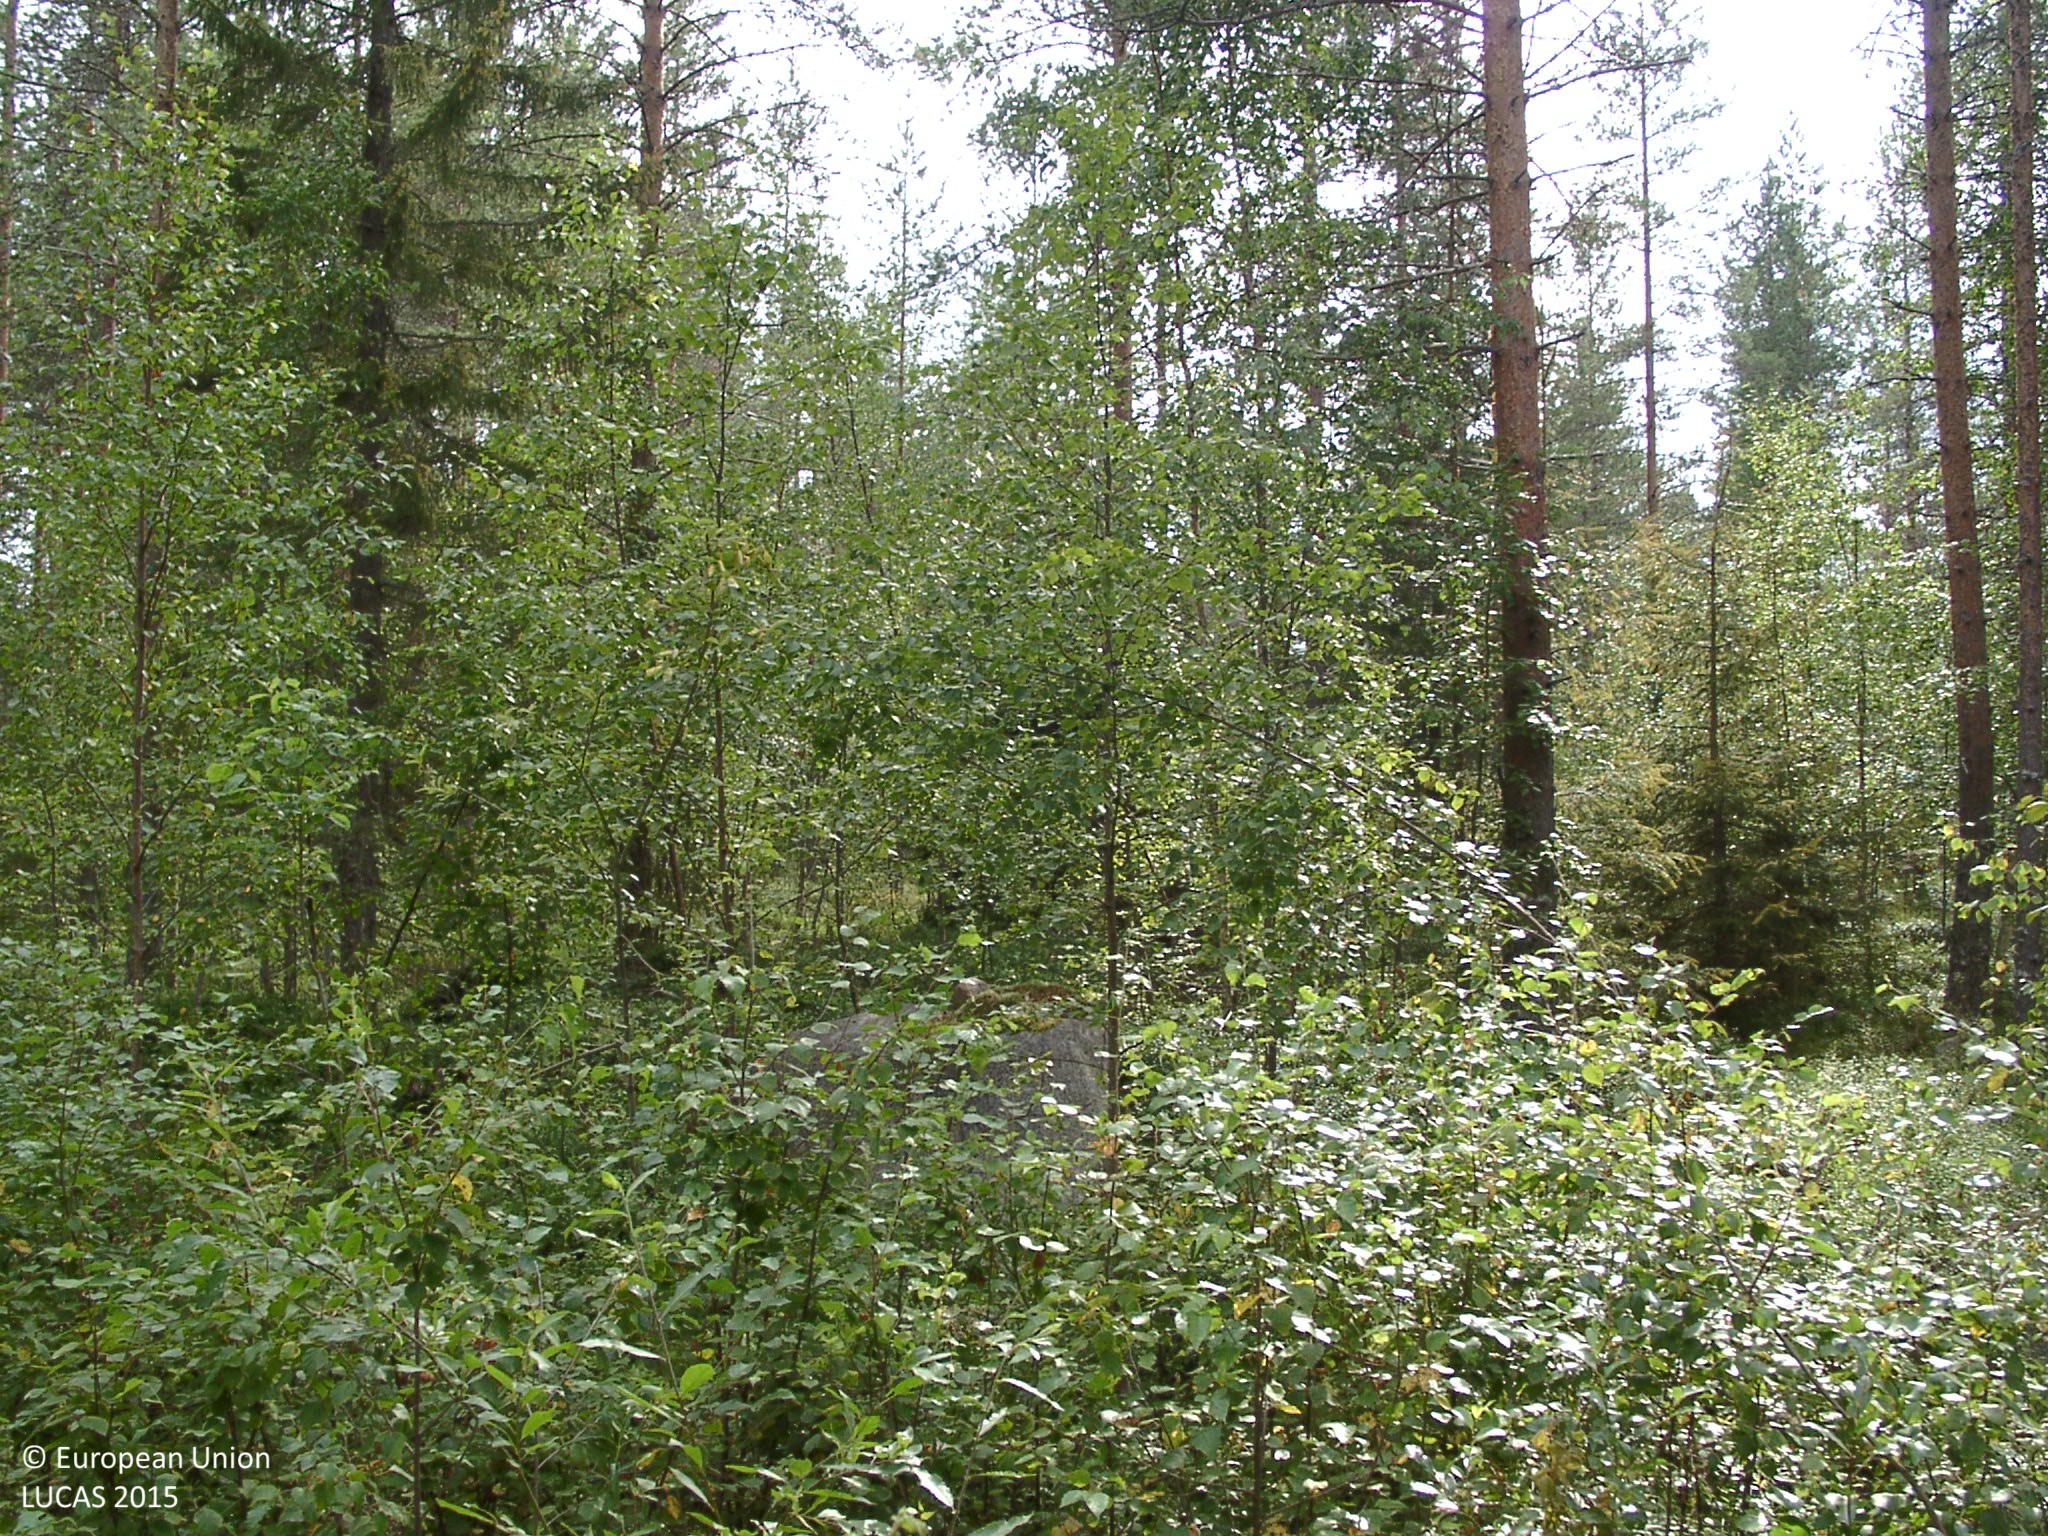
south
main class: Woodland
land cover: Pine dominated coniferous woodland
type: boreal forest
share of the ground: > 75 %
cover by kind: coniferous forest trees 65 %, shrubs 20 %, broadleaved forest trees 15 %
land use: Forestry
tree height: > 5 m
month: August
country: FI
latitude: 62.5917
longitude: 24.4387
